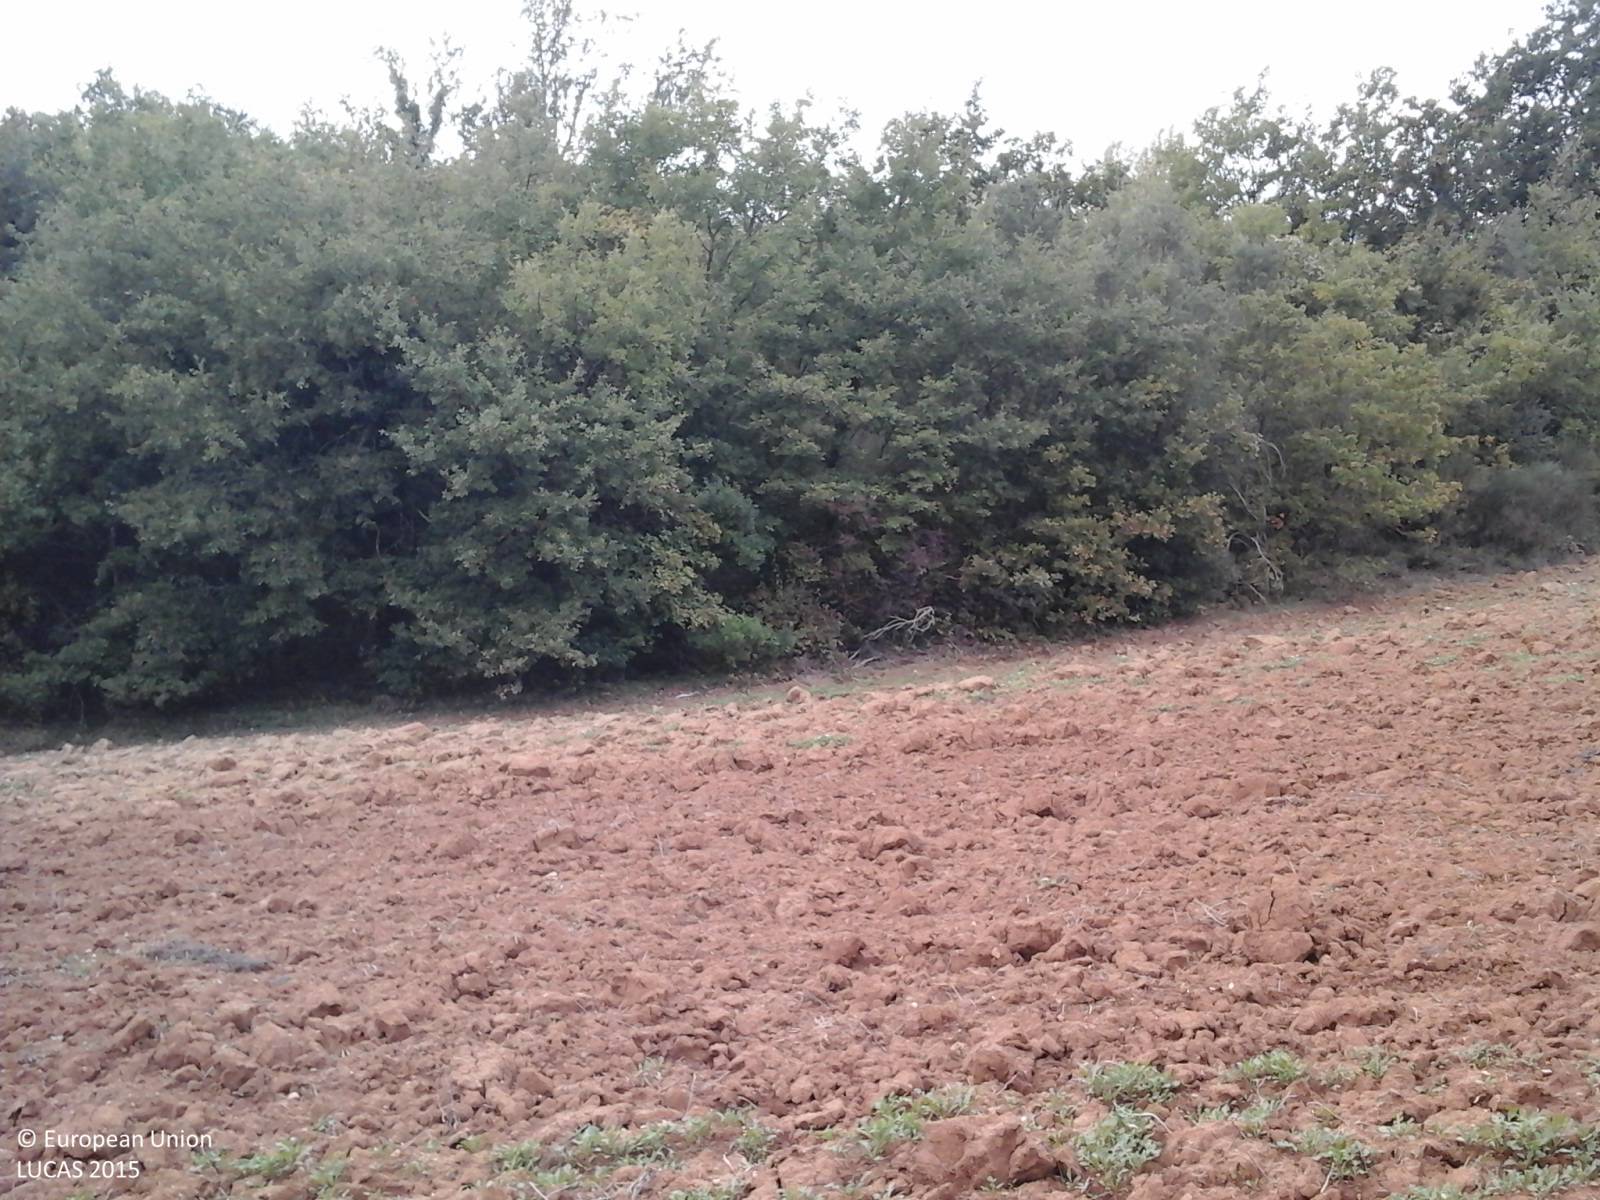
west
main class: Woodland
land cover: Broadleaved woodland
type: broadleaved evergreen forest
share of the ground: > 75 %
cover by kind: broadleaved forest trees 95 %, shrubs 5 %
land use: Forestry
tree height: > 5 m
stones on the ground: < 10 %
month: October
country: IT
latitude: 42.7209
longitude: 12.1789
